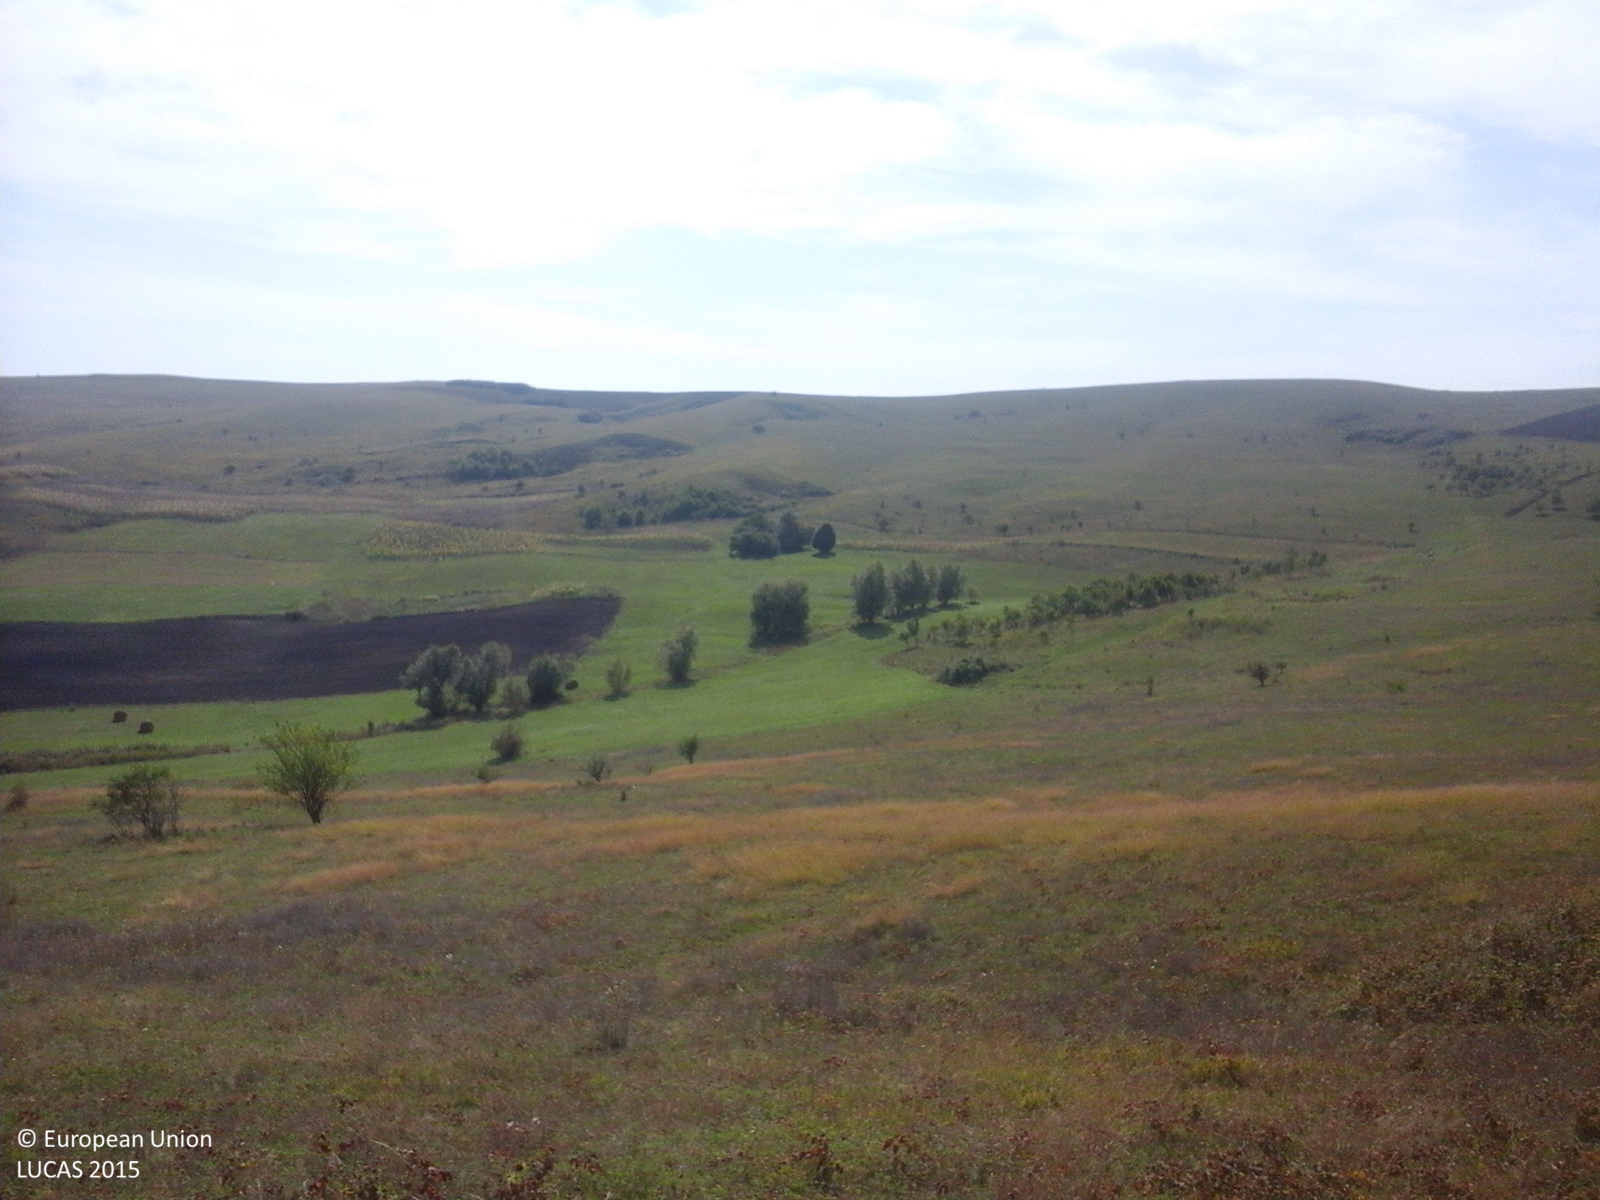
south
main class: Grassland
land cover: Grassland with sparse tree/shrub cover
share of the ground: > 75 %
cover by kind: herbaceous plants 95 %, broadleaved forest trees 5 %
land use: Agriculture (excluding fallow land and kitchen gardens)
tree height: < 5 m
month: September
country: RO
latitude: 46.7406
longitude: 23.8575
